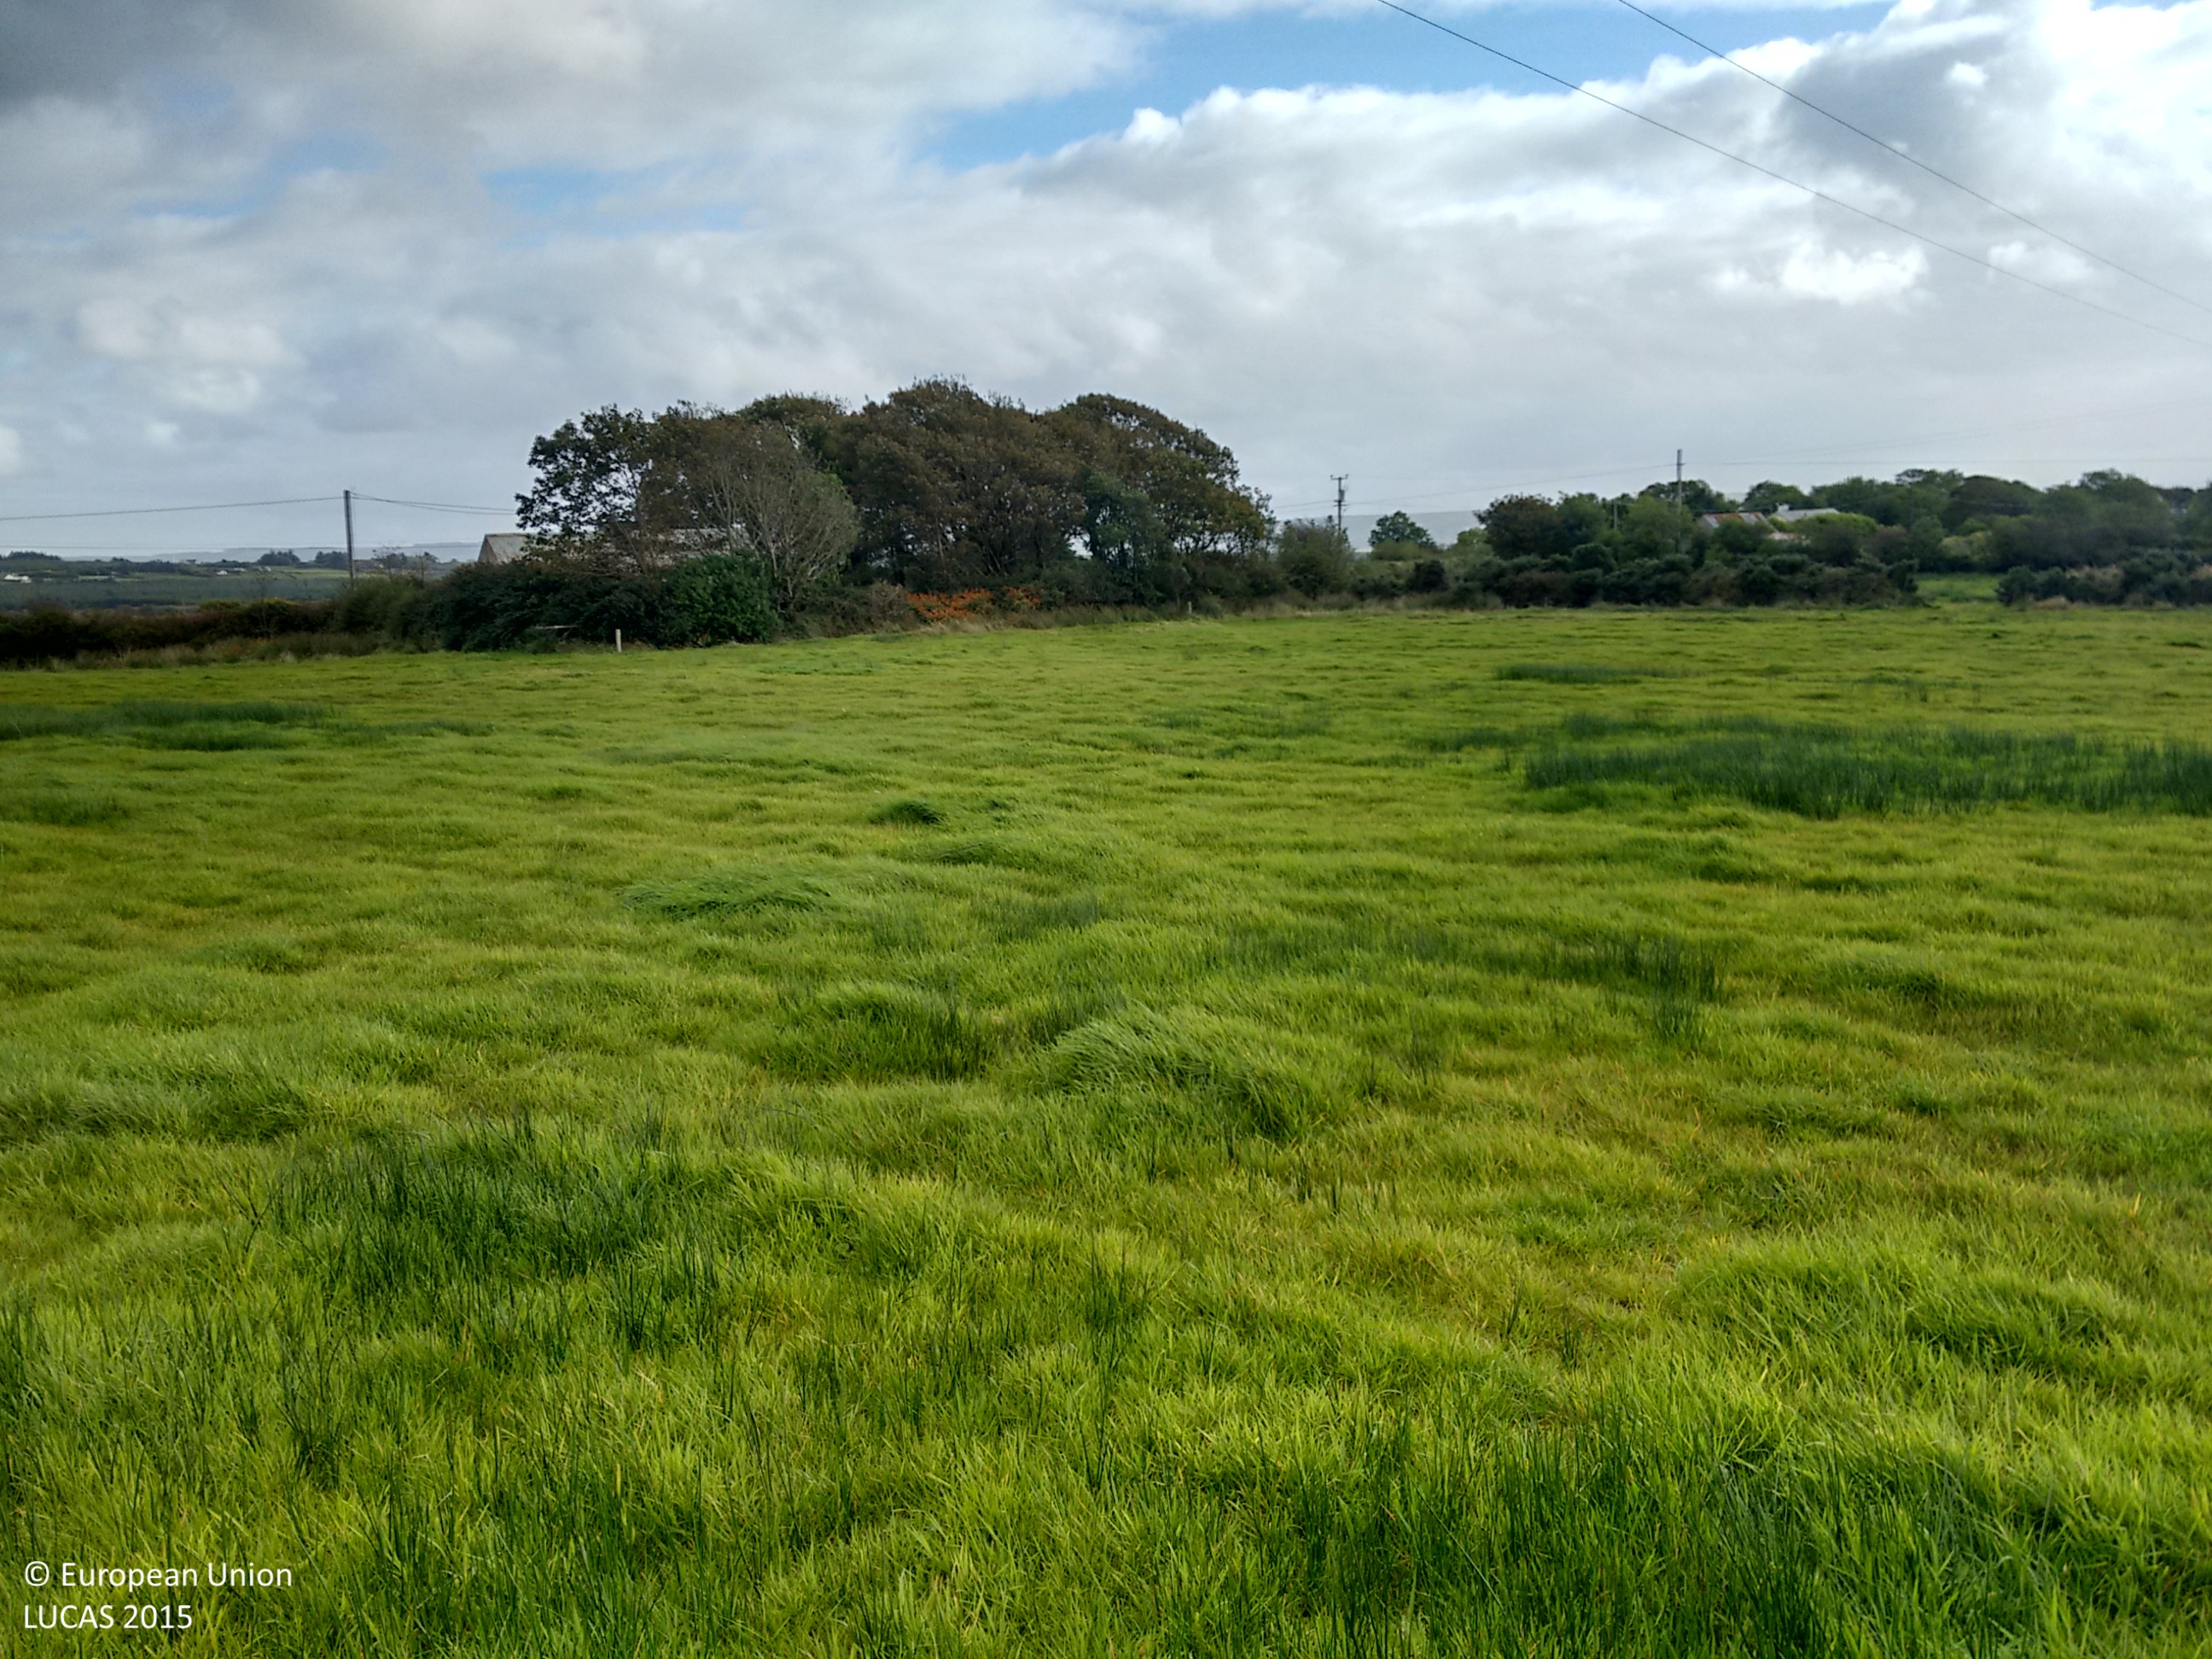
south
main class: Grassland
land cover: Grassland without tree/shrub cover
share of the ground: > 75 %
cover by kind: herbaceous plants 100 %
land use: Agriculture (excluding fallow land and kitchen gardens)
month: September
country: IE
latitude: 52.5280
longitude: -9.3140
